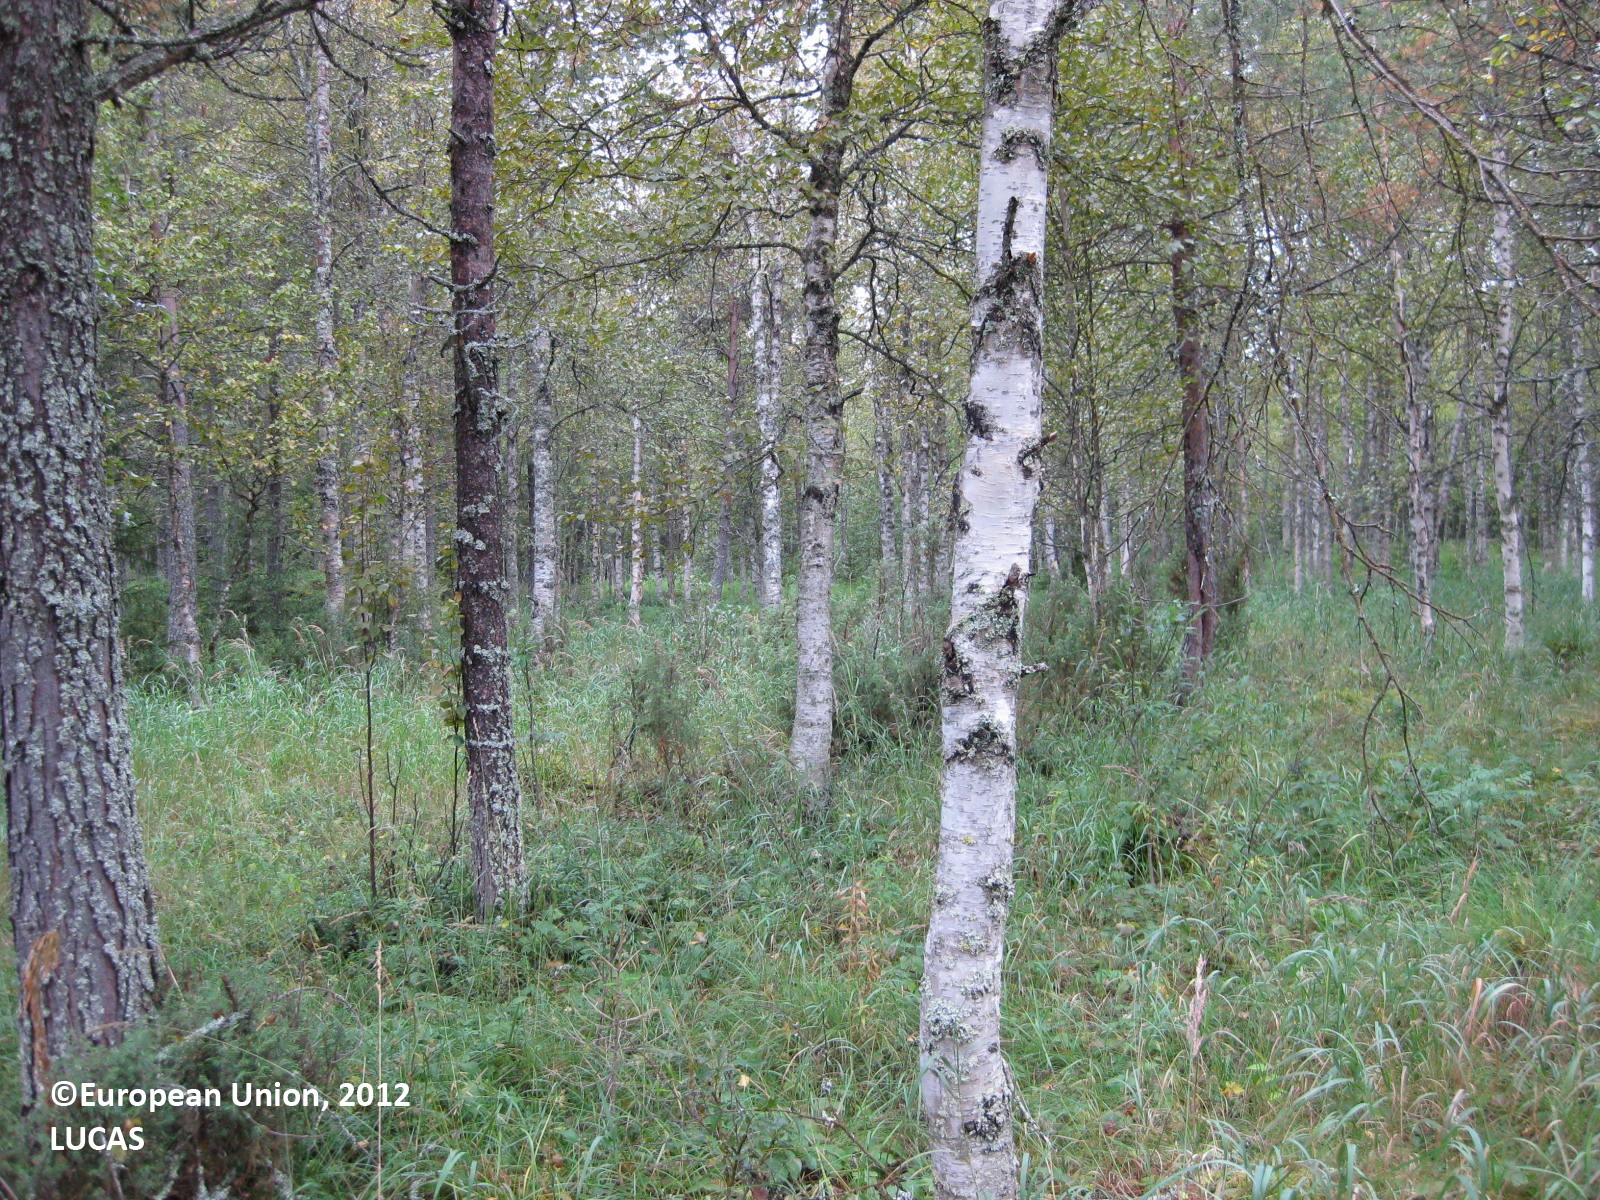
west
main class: Woodland
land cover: Pine dominated mixed woodland
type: boreal forest
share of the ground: 50 - 75 %
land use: Forestry
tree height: > 5 m
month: August
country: FI
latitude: 66.0889
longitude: 28.7560
